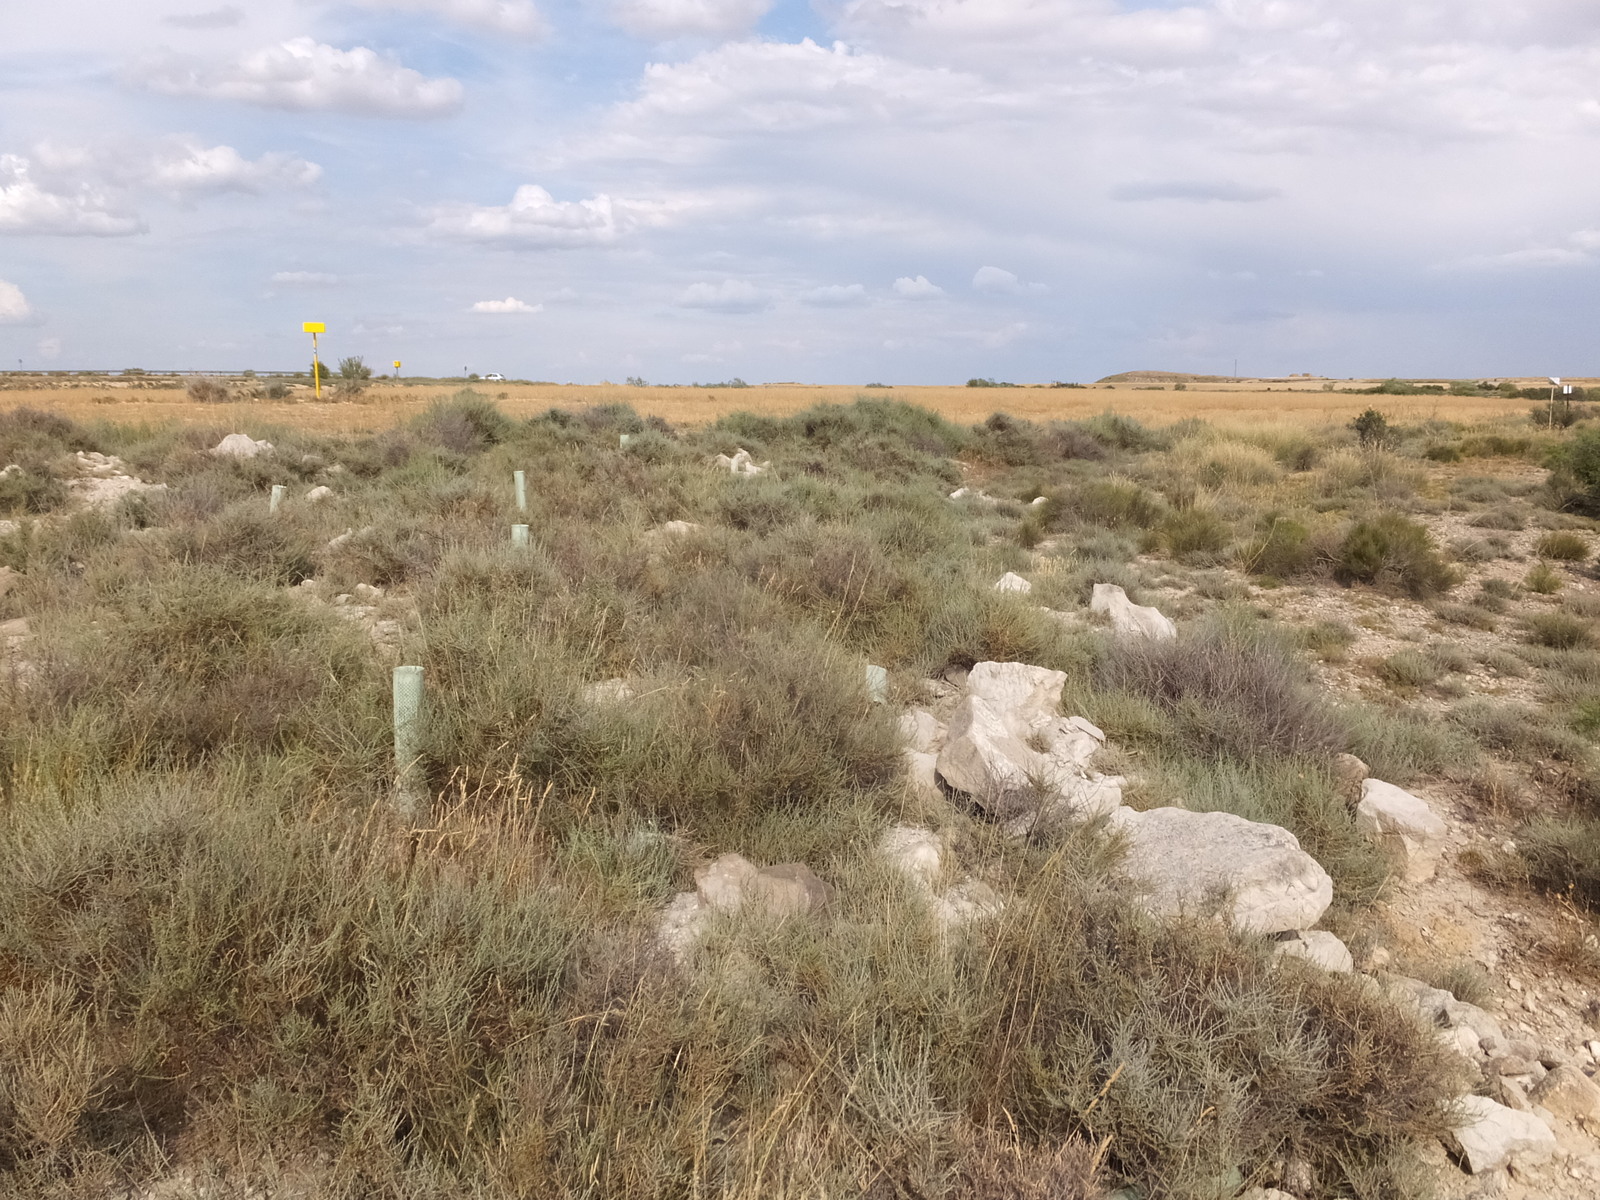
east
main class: Shrubland
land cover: Shrubland with sparse tree cover
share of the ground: 50 - 75 %
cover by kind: shrubs 60 %, herbaceous plants 35 %, coniferous forest trees 5 %
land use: Semi-natural and natural areas not in use
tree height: < 5 m
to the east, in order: Shrubland with sparse tree cover; Grassland without tree/shrub cover; Shruby margins; Paved roads, cycling and walking lanes; Ditches and canals; Shruby margins; Paved roads, cycling and walking lanes; Fences; Inland fresh running water; Shrubland without tree cover
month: June
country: ES
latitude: 41.5622
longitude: 0.0447
